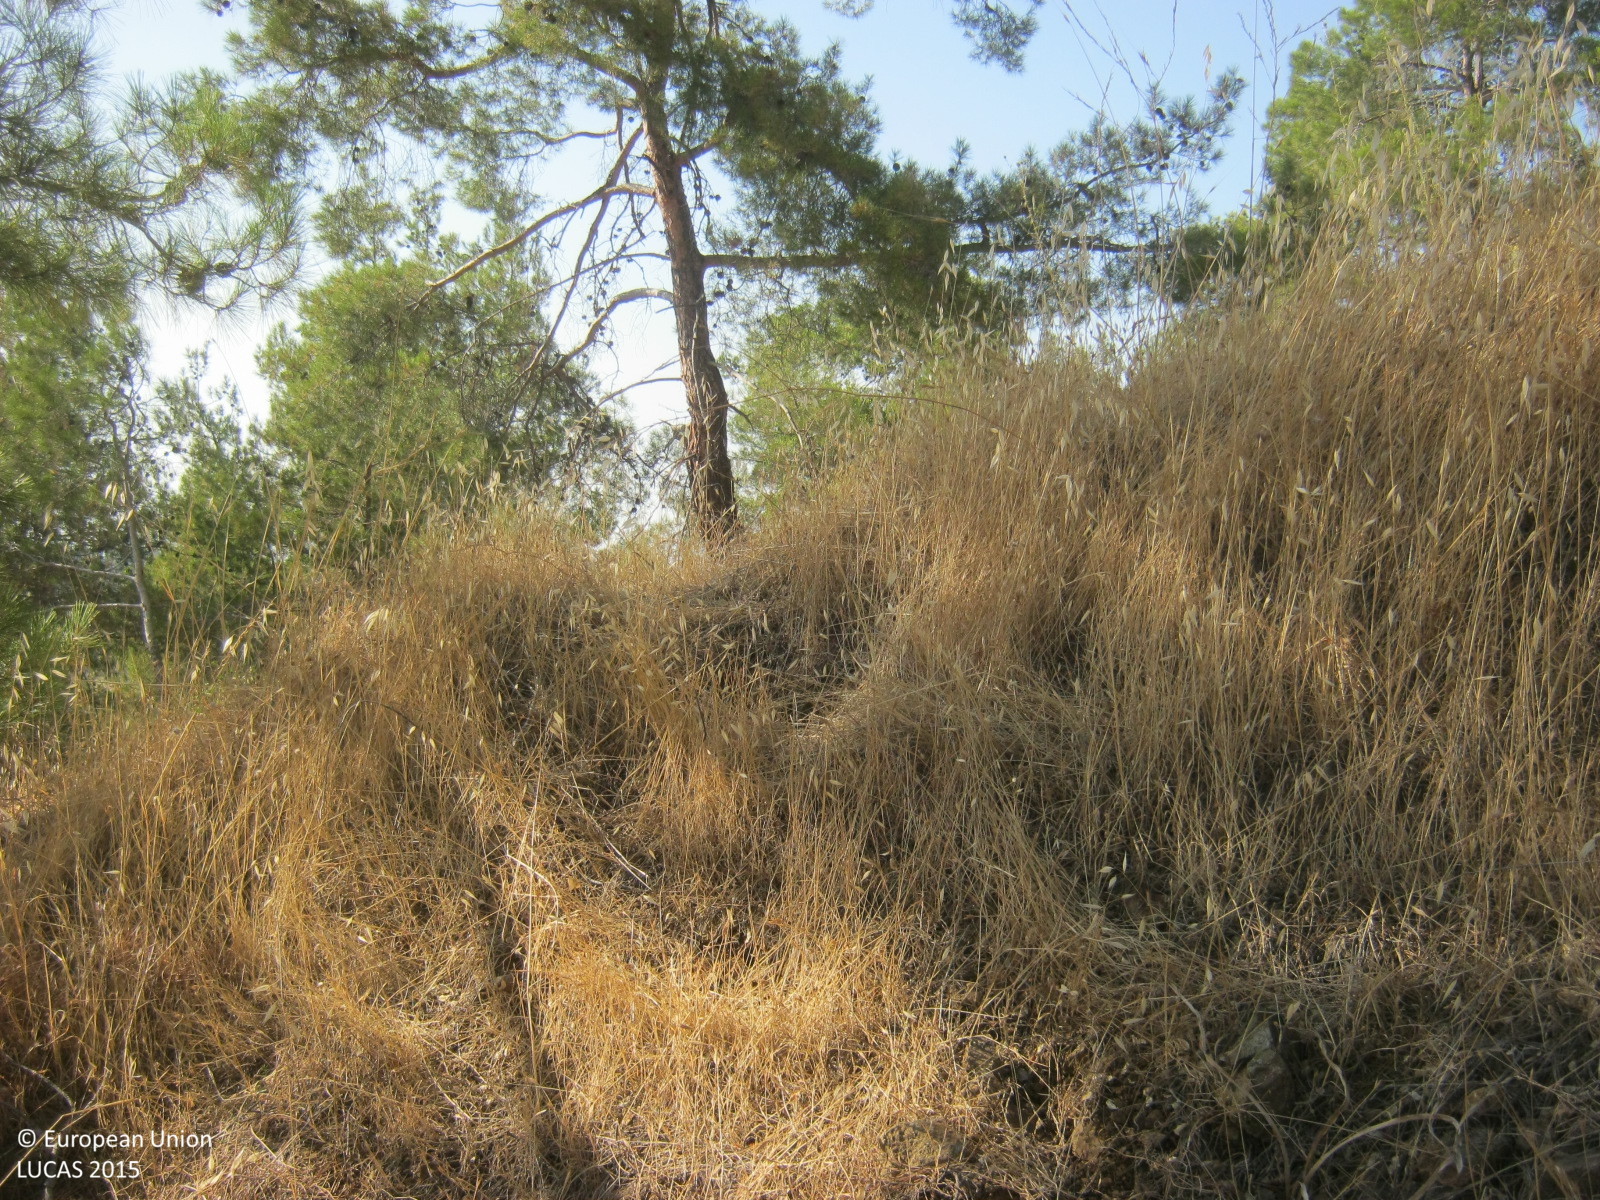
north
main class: Woodland
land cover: Pine dominated coniferous woodland
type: coniferous forest of the mediterranean region
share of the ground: 50 - 75 %
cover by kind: coniferous forest trees 70 %, herbaceous plants 15 %, shrubs 10 %, unconsolidated bare surface 5 %
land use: Forestry
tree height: > 5 m
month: June
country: CY
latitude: 34.9914
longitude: 33.1079
